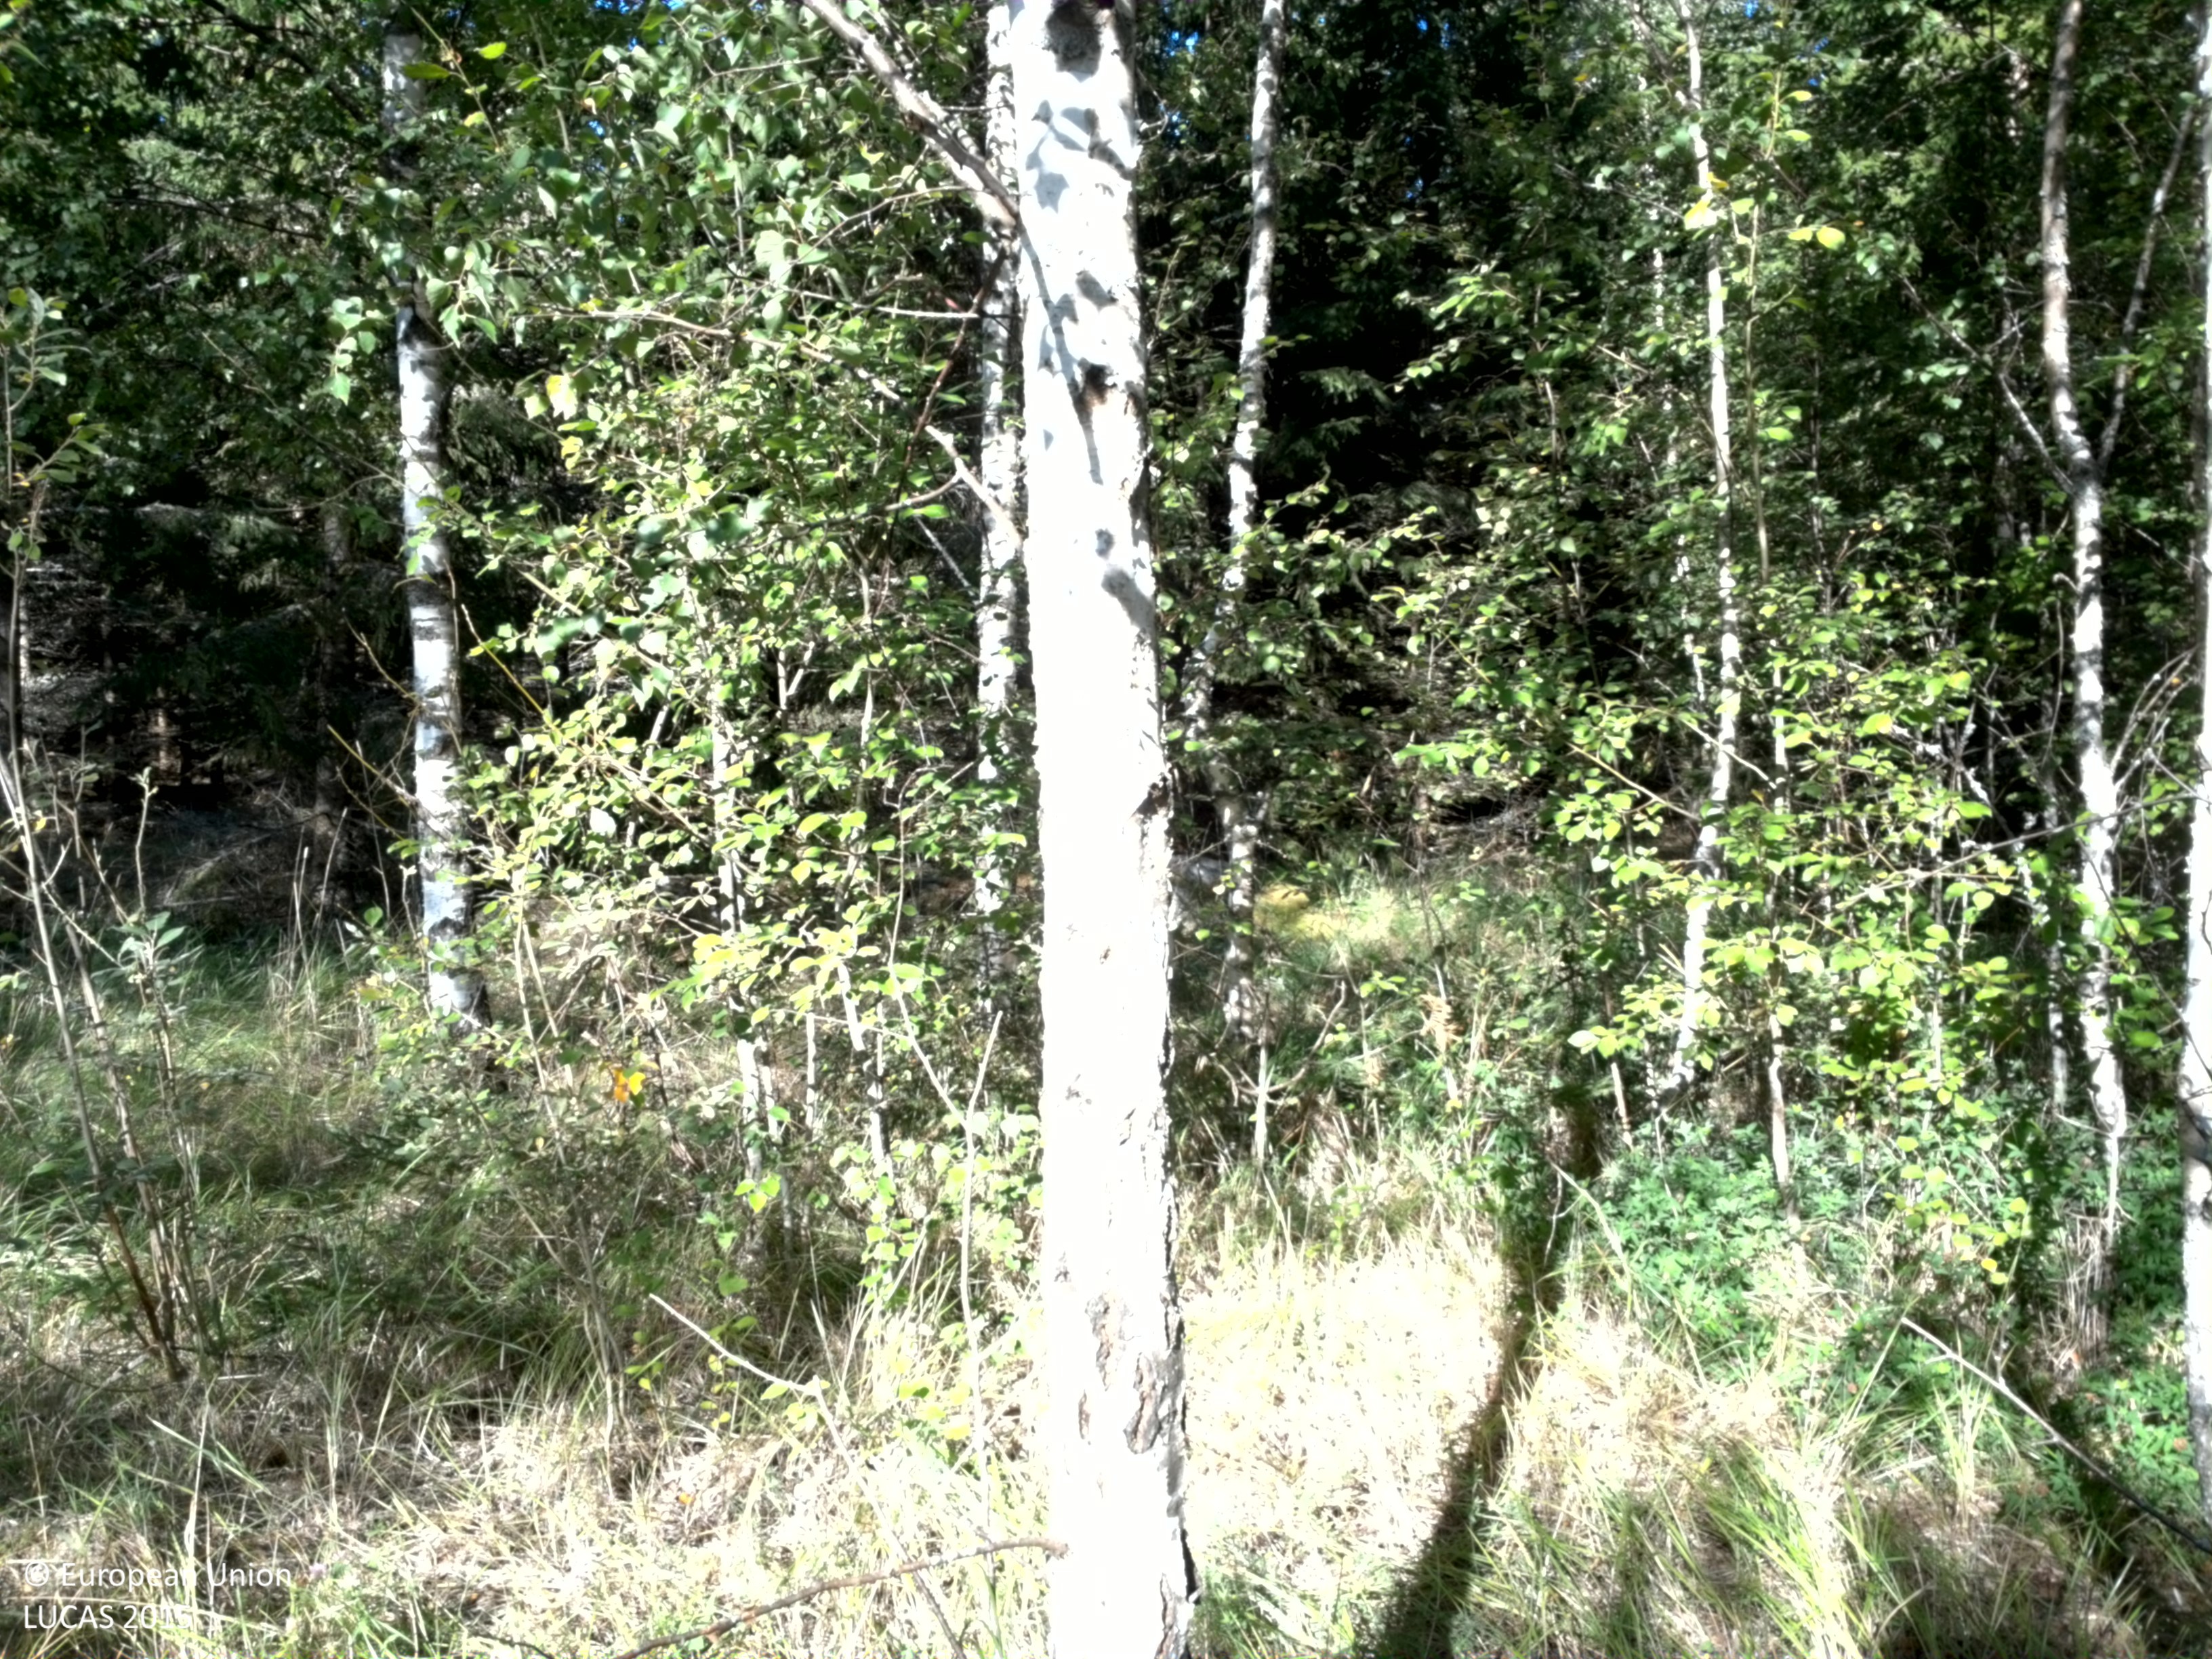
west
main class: Woodland
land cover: Broadleaved woodland
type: boreal forest
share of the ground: 50 - 75 %
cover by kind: broadleaved forest trees 60 %, herbaceous plants 40 %
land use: Forestry
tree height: > 5 m
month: August
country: SE
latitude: 59.8773
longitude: 16.6905
